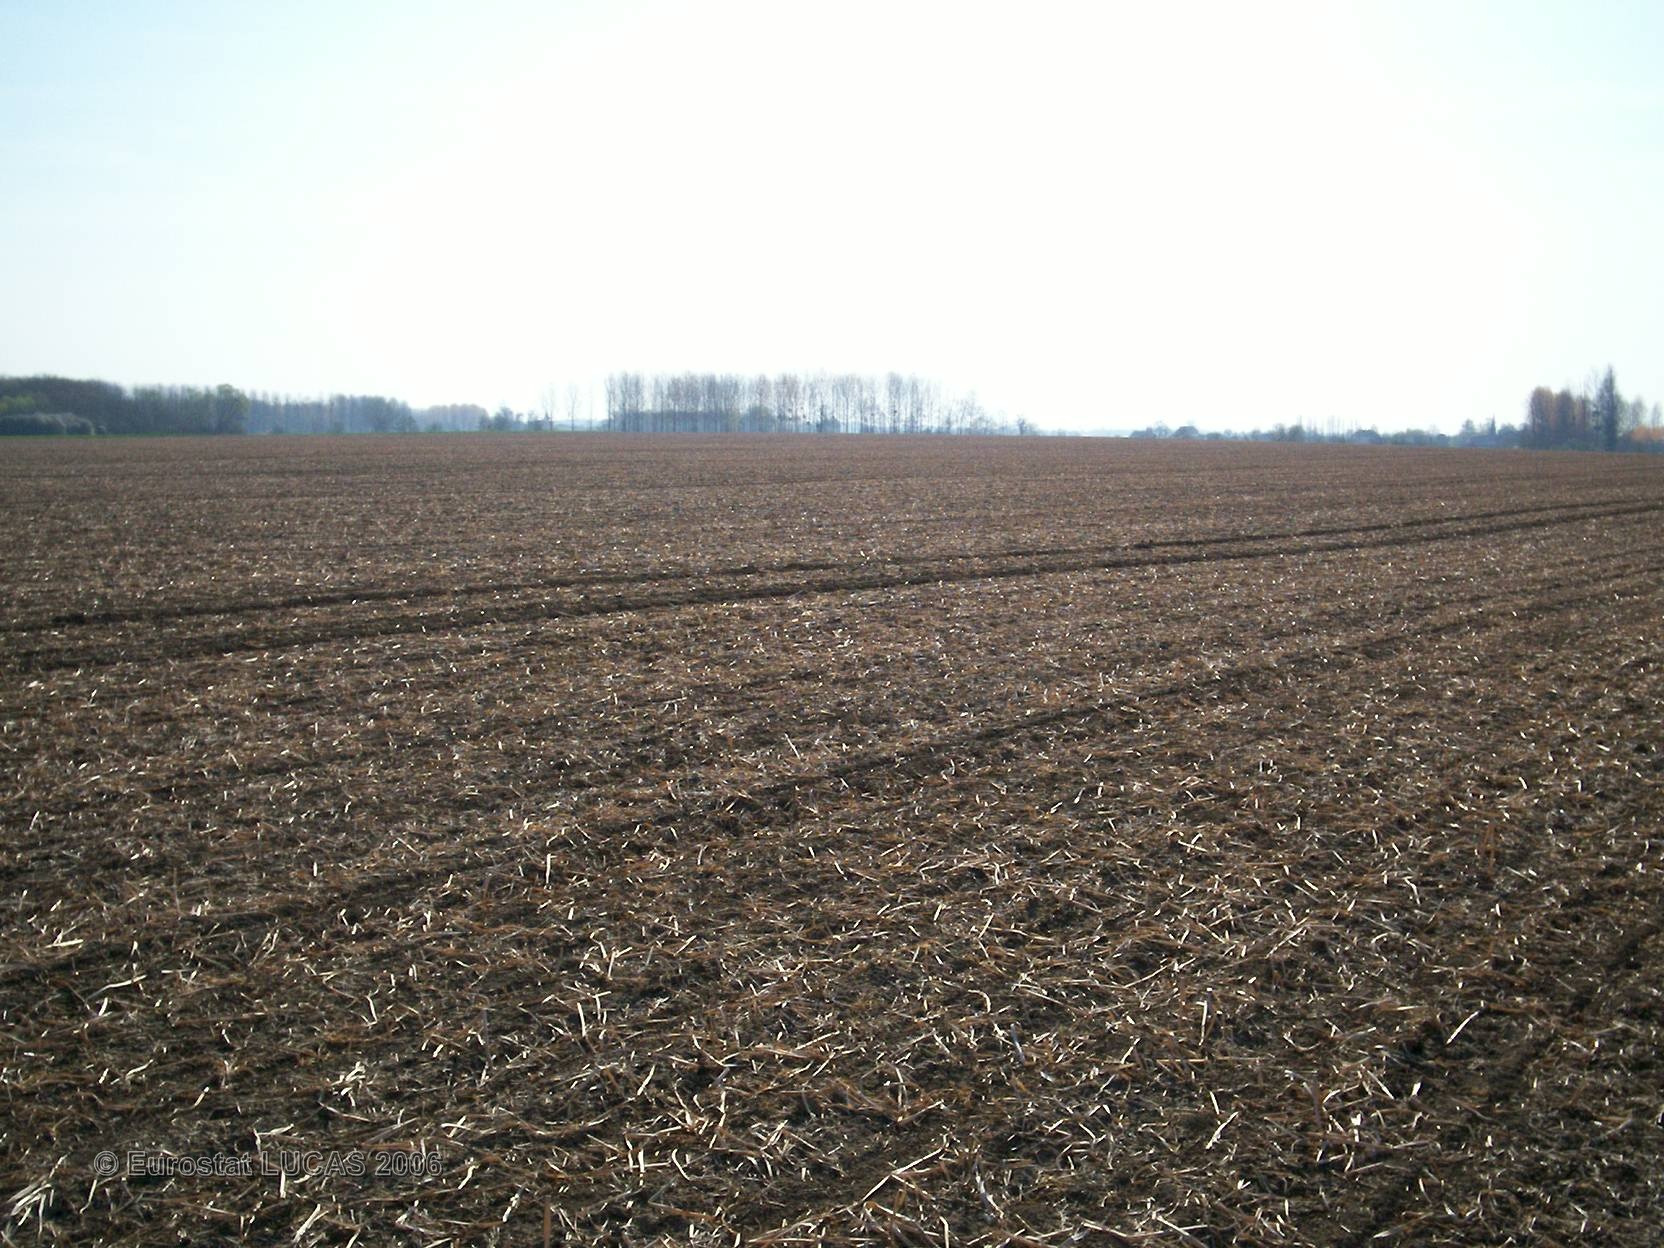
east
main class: Cropland
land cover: Sugar beet
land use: Agriculture (excluding fallow land and kitchen gardens)
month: April
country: FR
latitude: 48.4660
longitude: 4.5198
